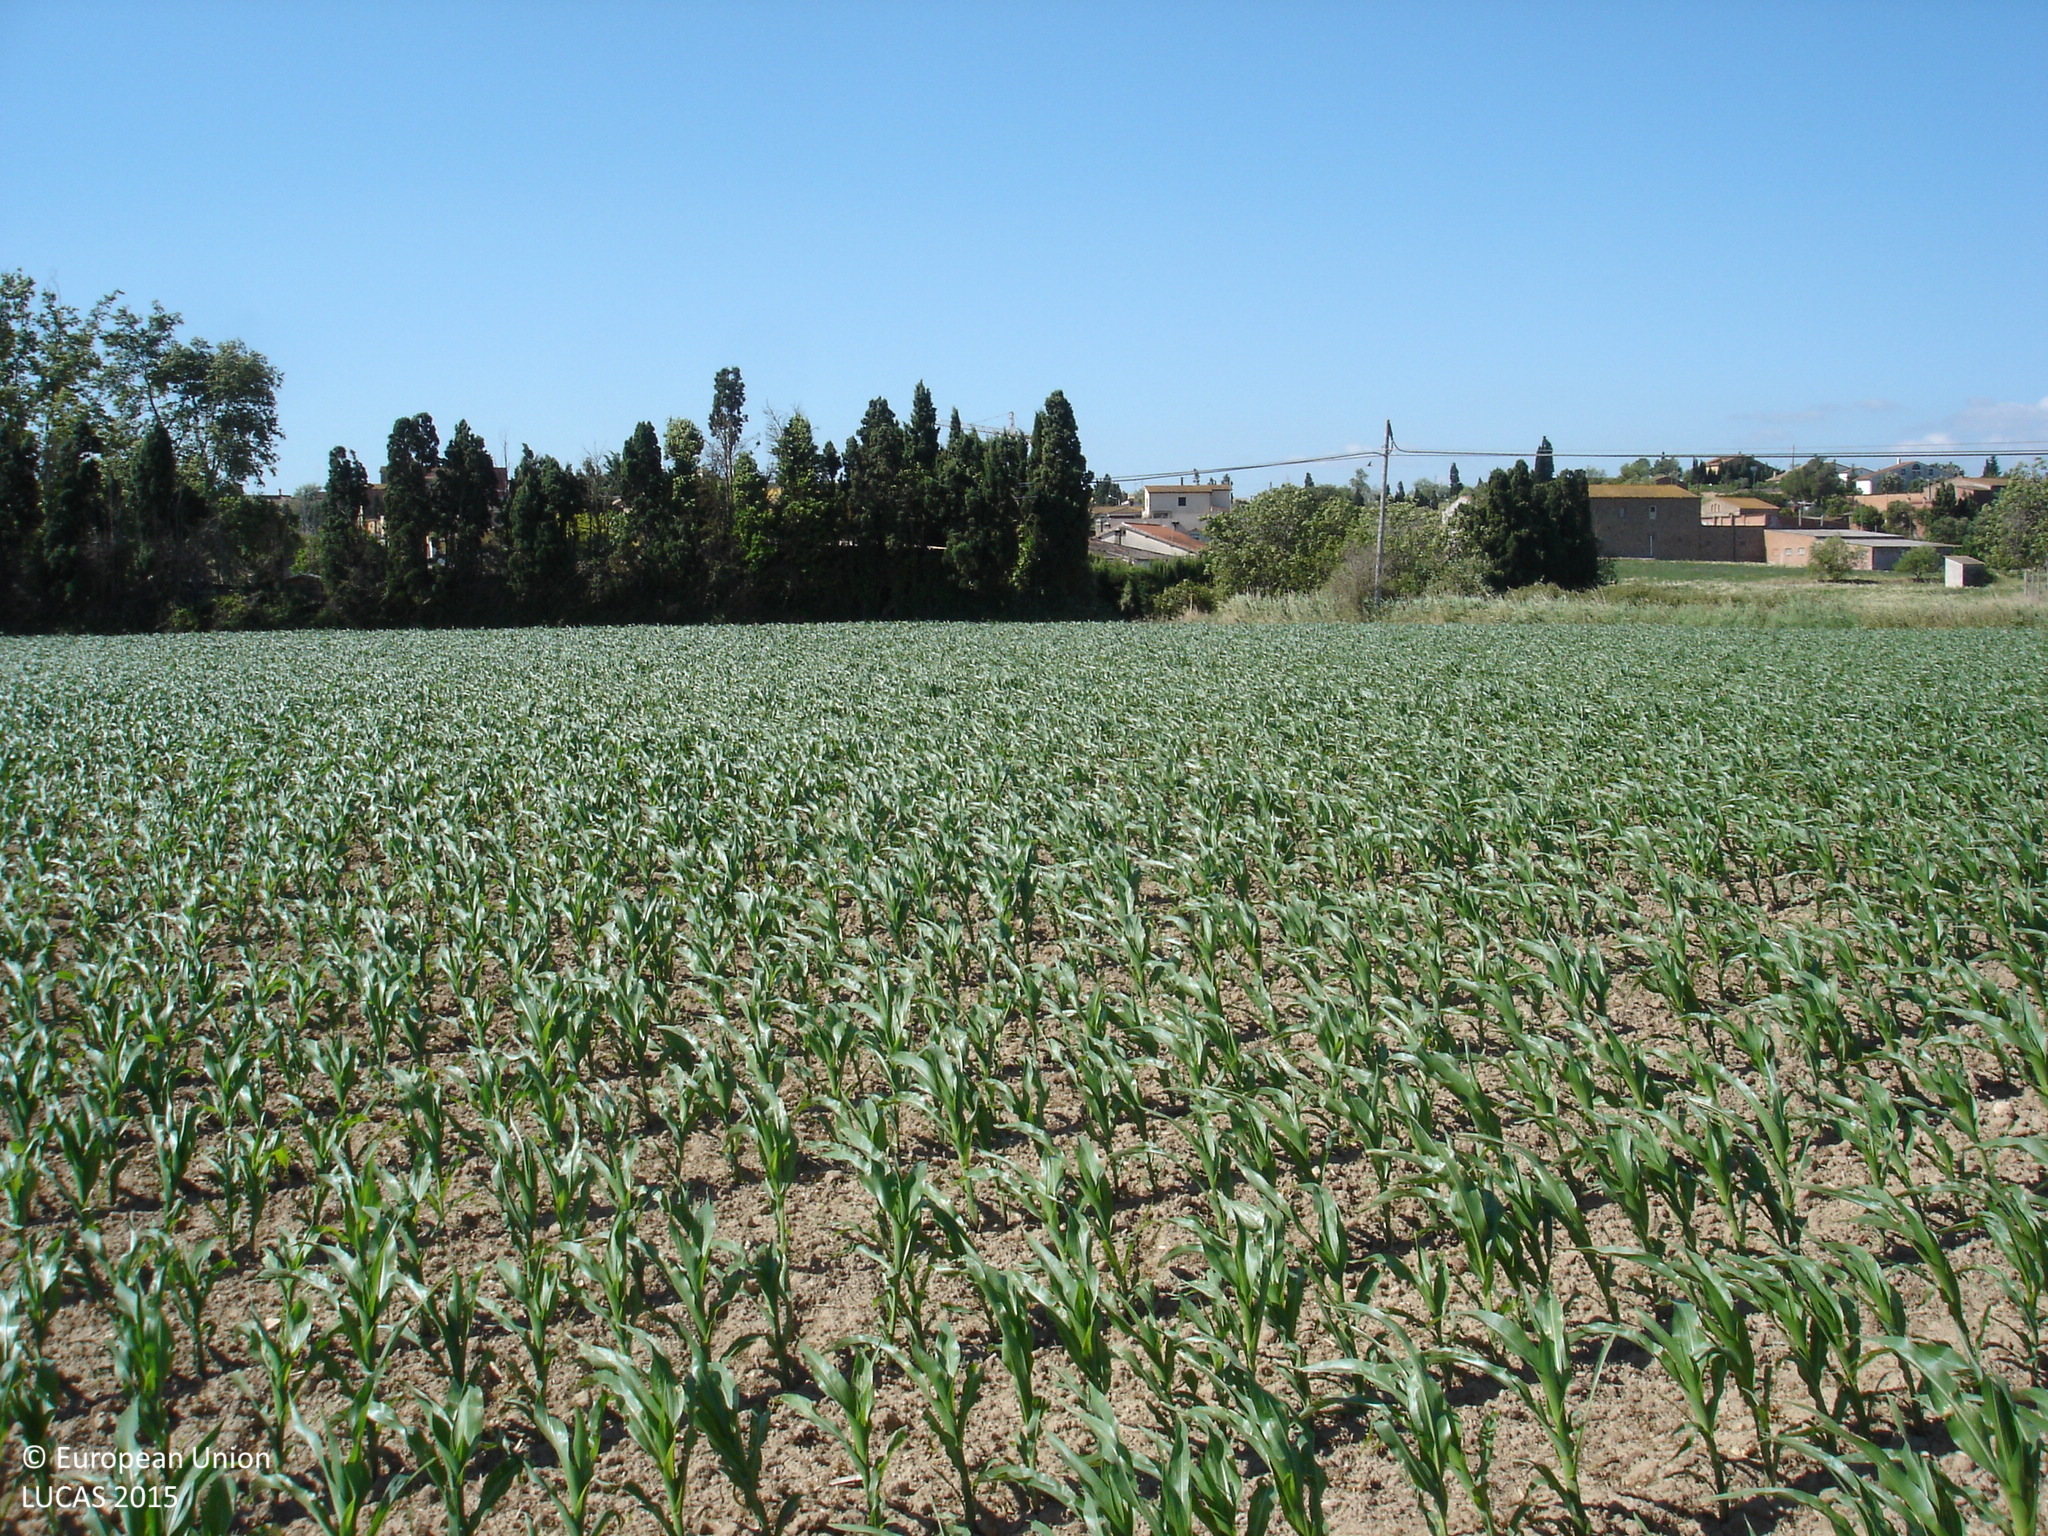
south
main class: Cropland
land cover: Maize
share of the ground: 25 - 50 %
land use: Agriculture (excluding fallow land and kitchen gardens)
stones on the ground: < 10 %
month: May
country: ES
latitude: 42.1095
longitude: 3.0856
